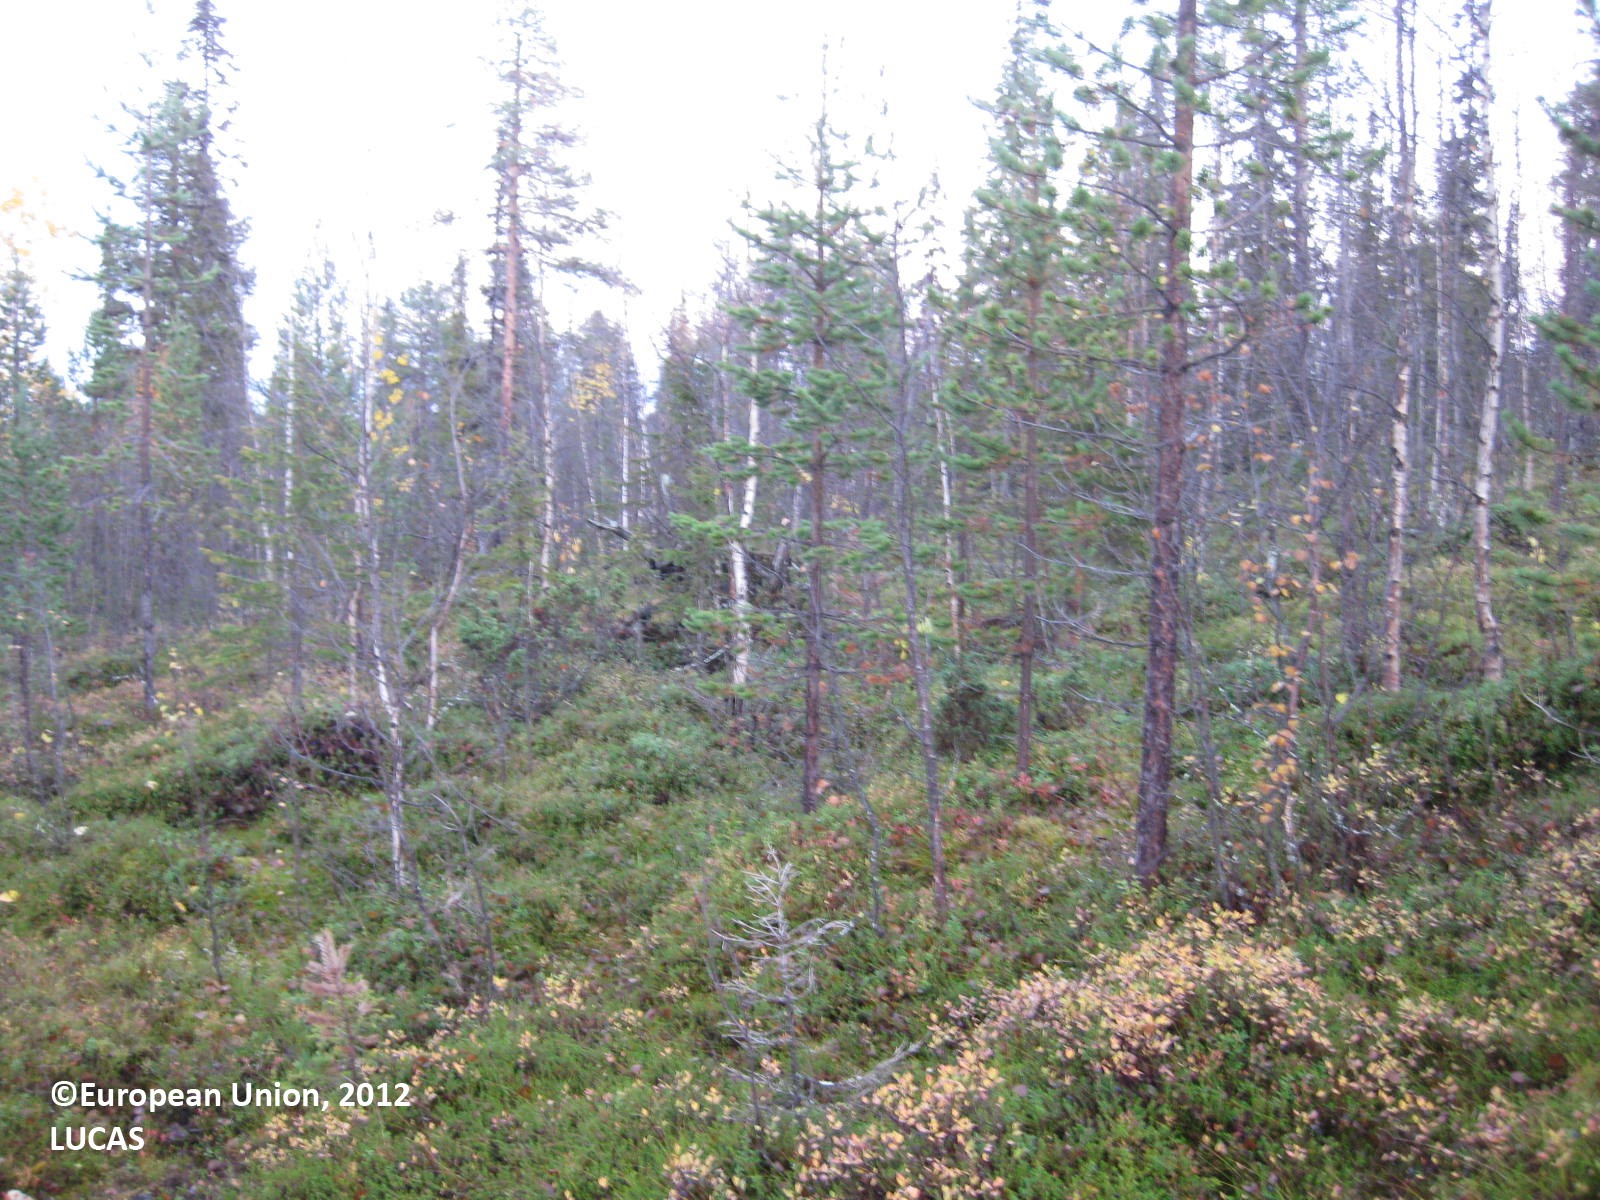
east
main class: Woodland
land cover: Other mixed woodland
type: boreal forest
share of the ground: 25 - 50 %
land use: Semi-natural and natural areas not in use
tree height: > 5 m
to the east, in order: Other mixed woodland
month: September
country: FI
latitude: 68.1526
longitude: 24.1504
